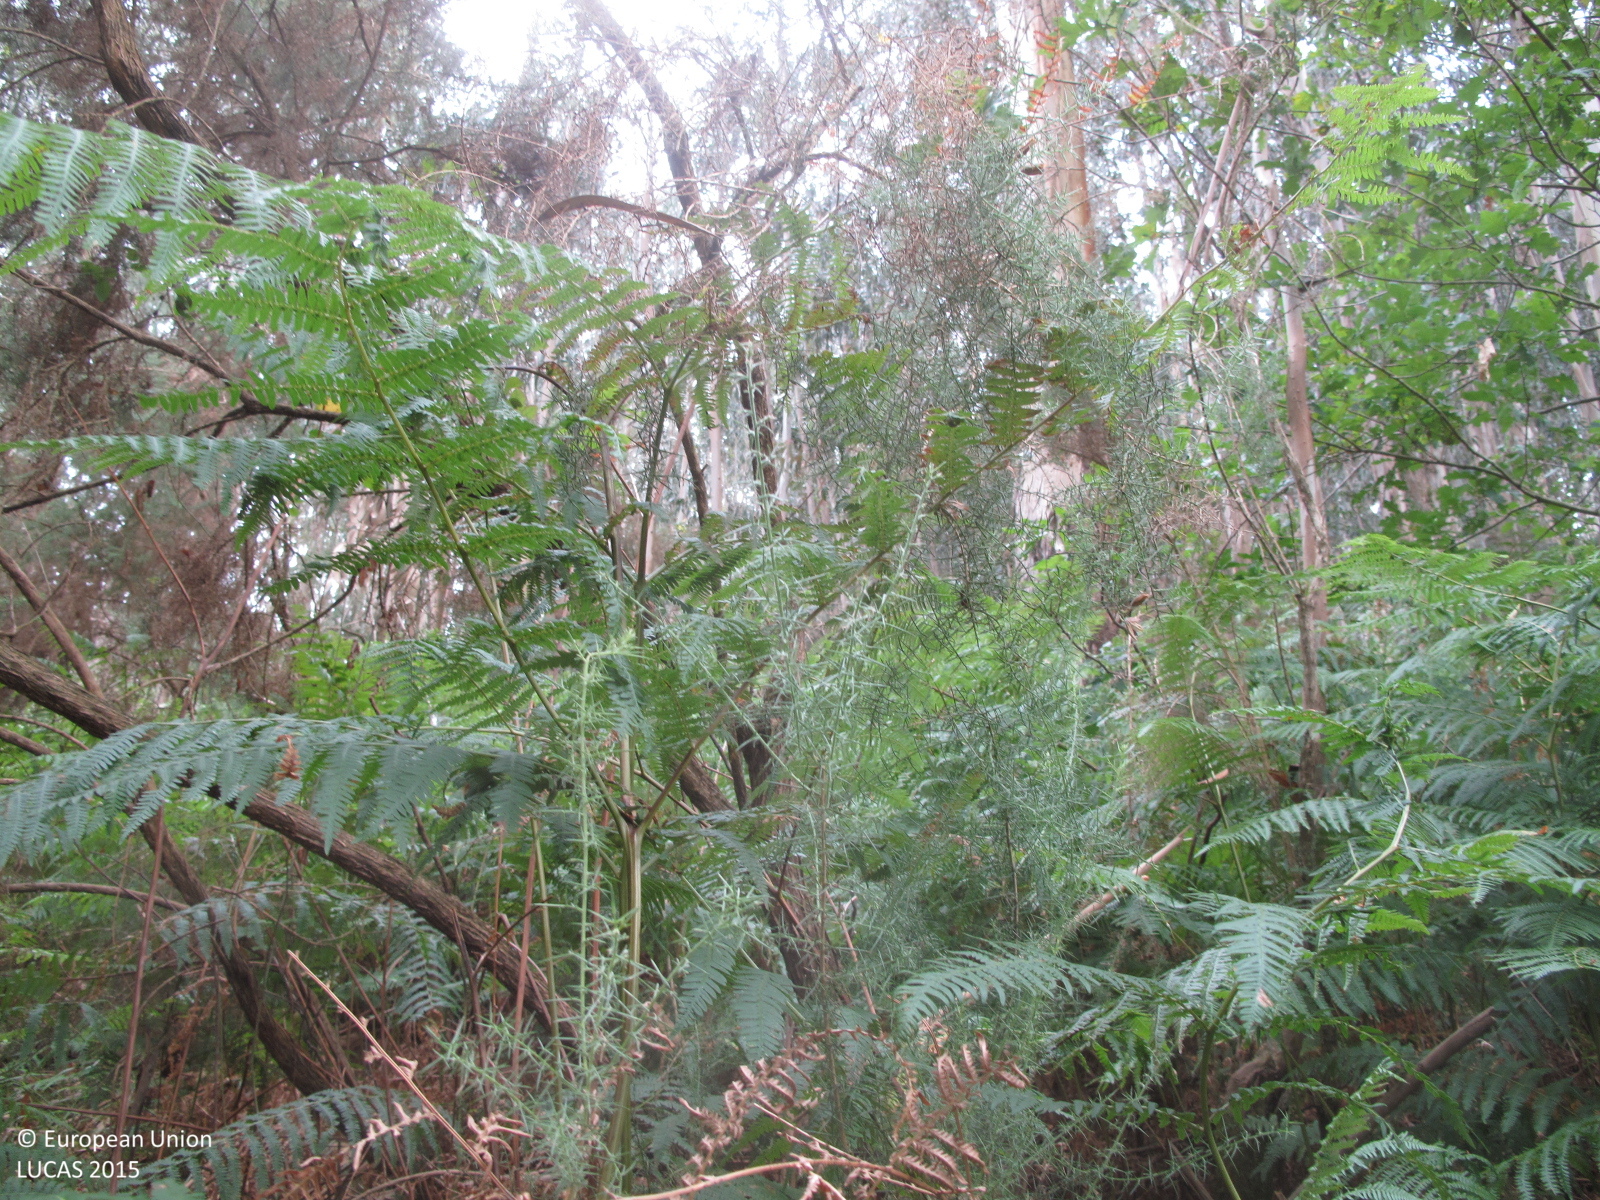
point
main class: Woodland
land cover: Broadleaved woodland
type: exotic forest
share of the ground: 50 - 75 %
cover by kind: broadleaved forest trees 60 %, shrubs 20 %, herbaceous plants 20 %
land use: Forestry
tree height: > 5 m
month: July
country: ES
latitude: 43.6346
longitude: -7.8555
